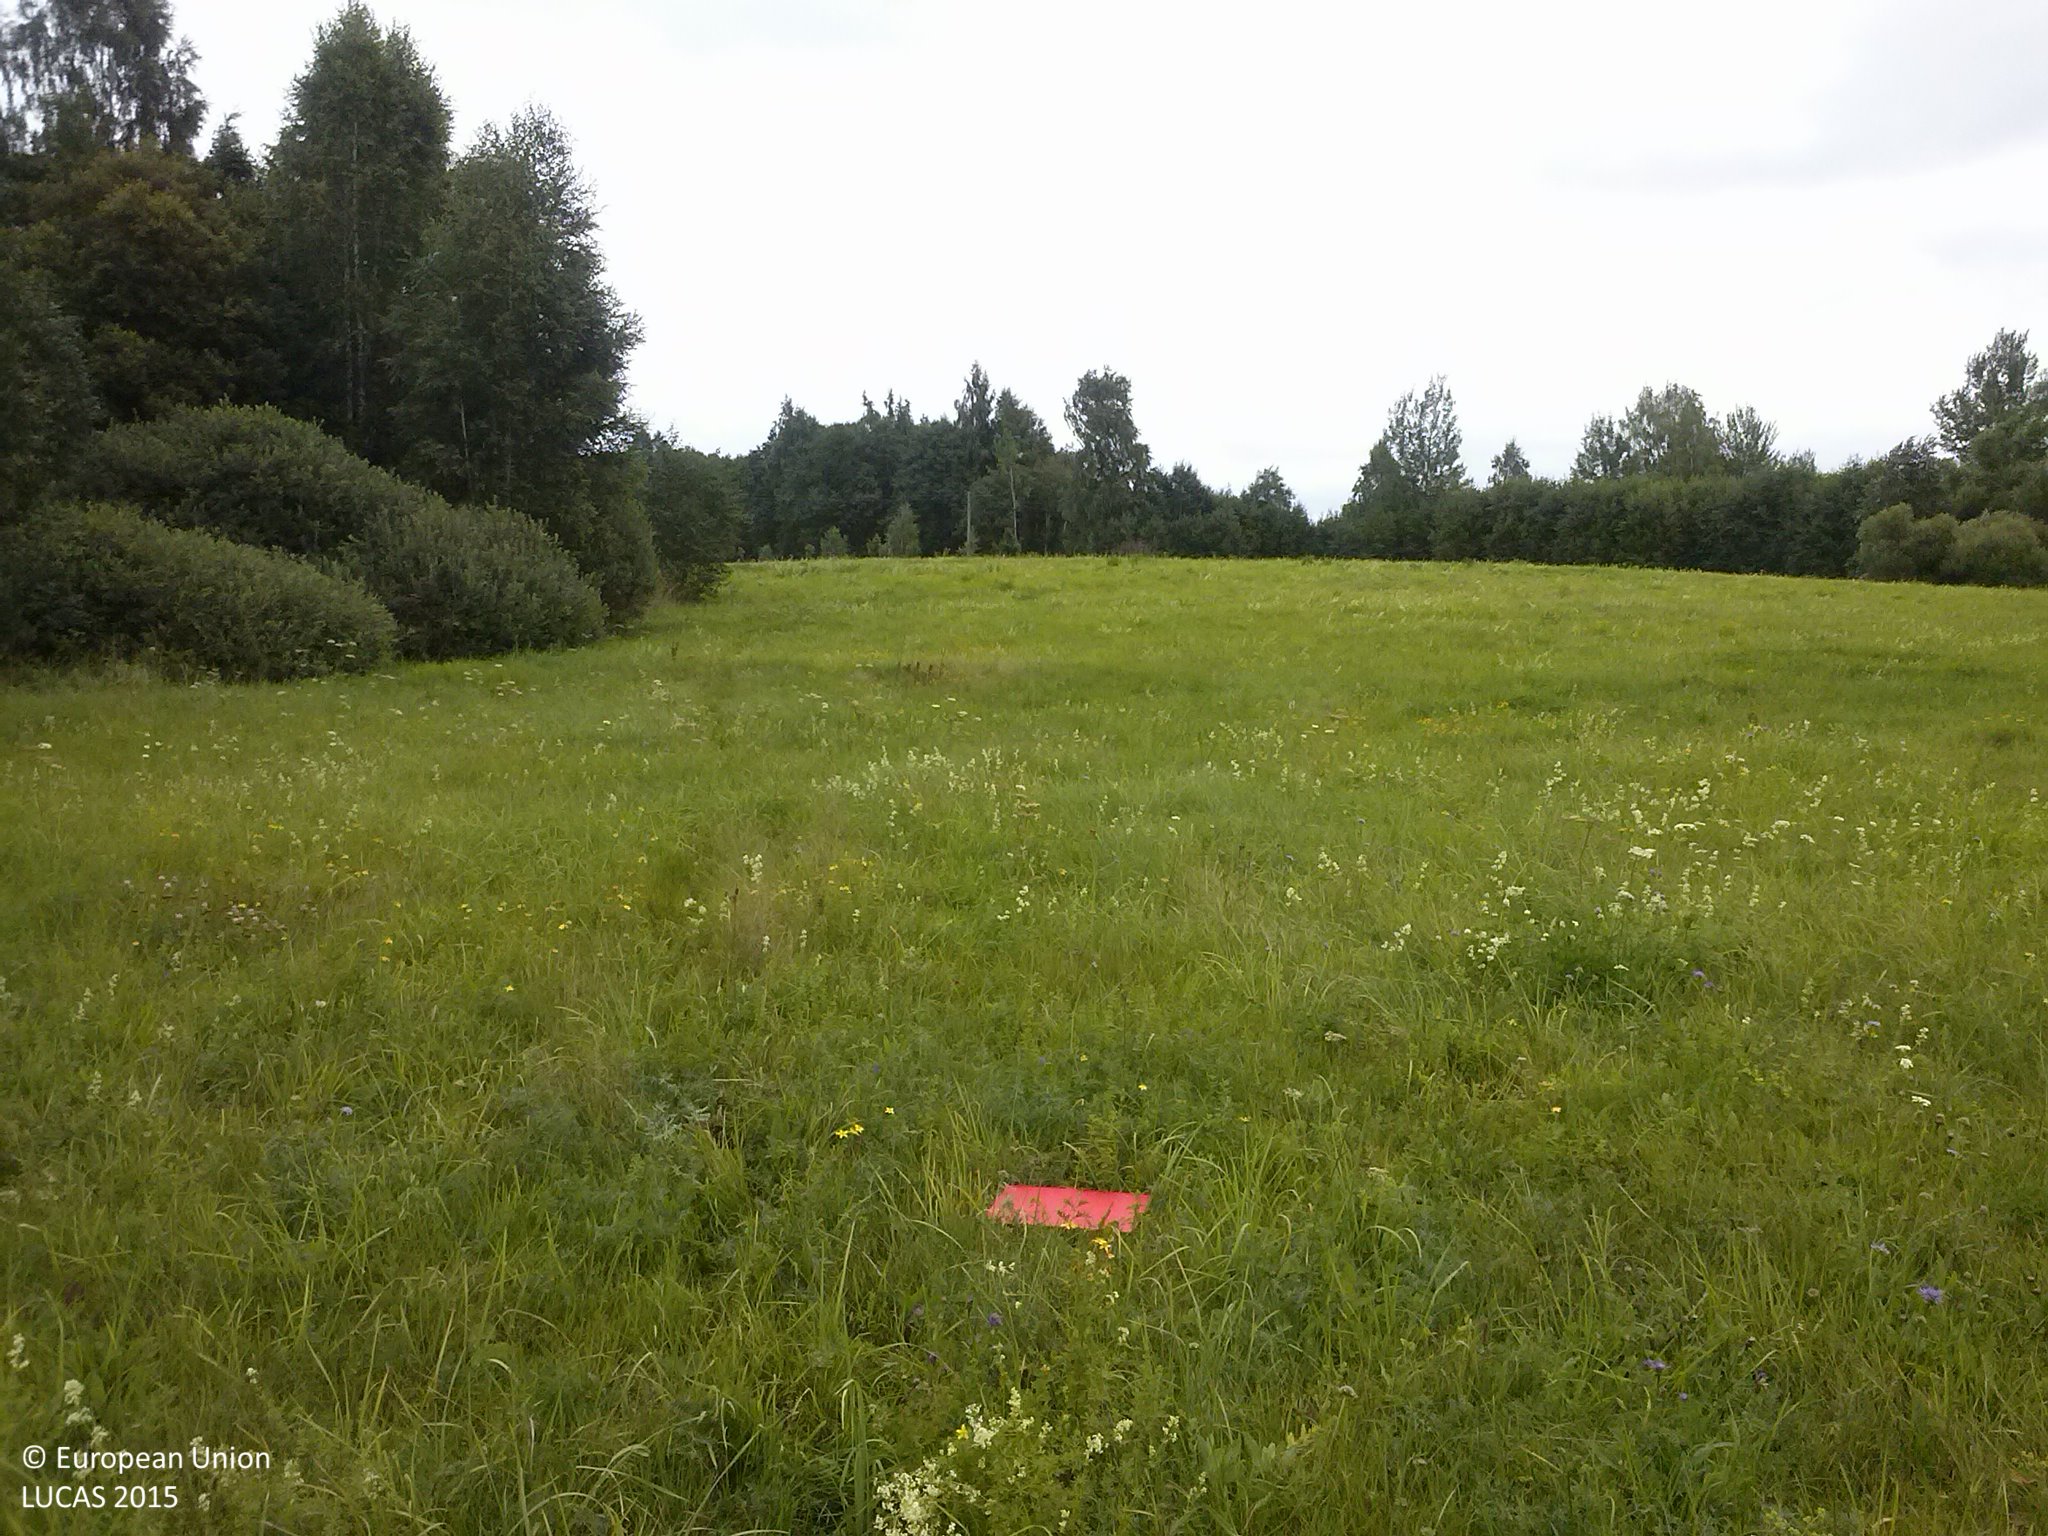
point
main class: Grassland
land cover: Grassland without tree/shrub cover
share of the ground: > 75 %
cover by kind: herbaceous plants 100 %
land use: Agriculture (excluding fallow land and kitchen gardens)
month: August
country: LV
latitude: 56.2340
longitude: 26.7571
